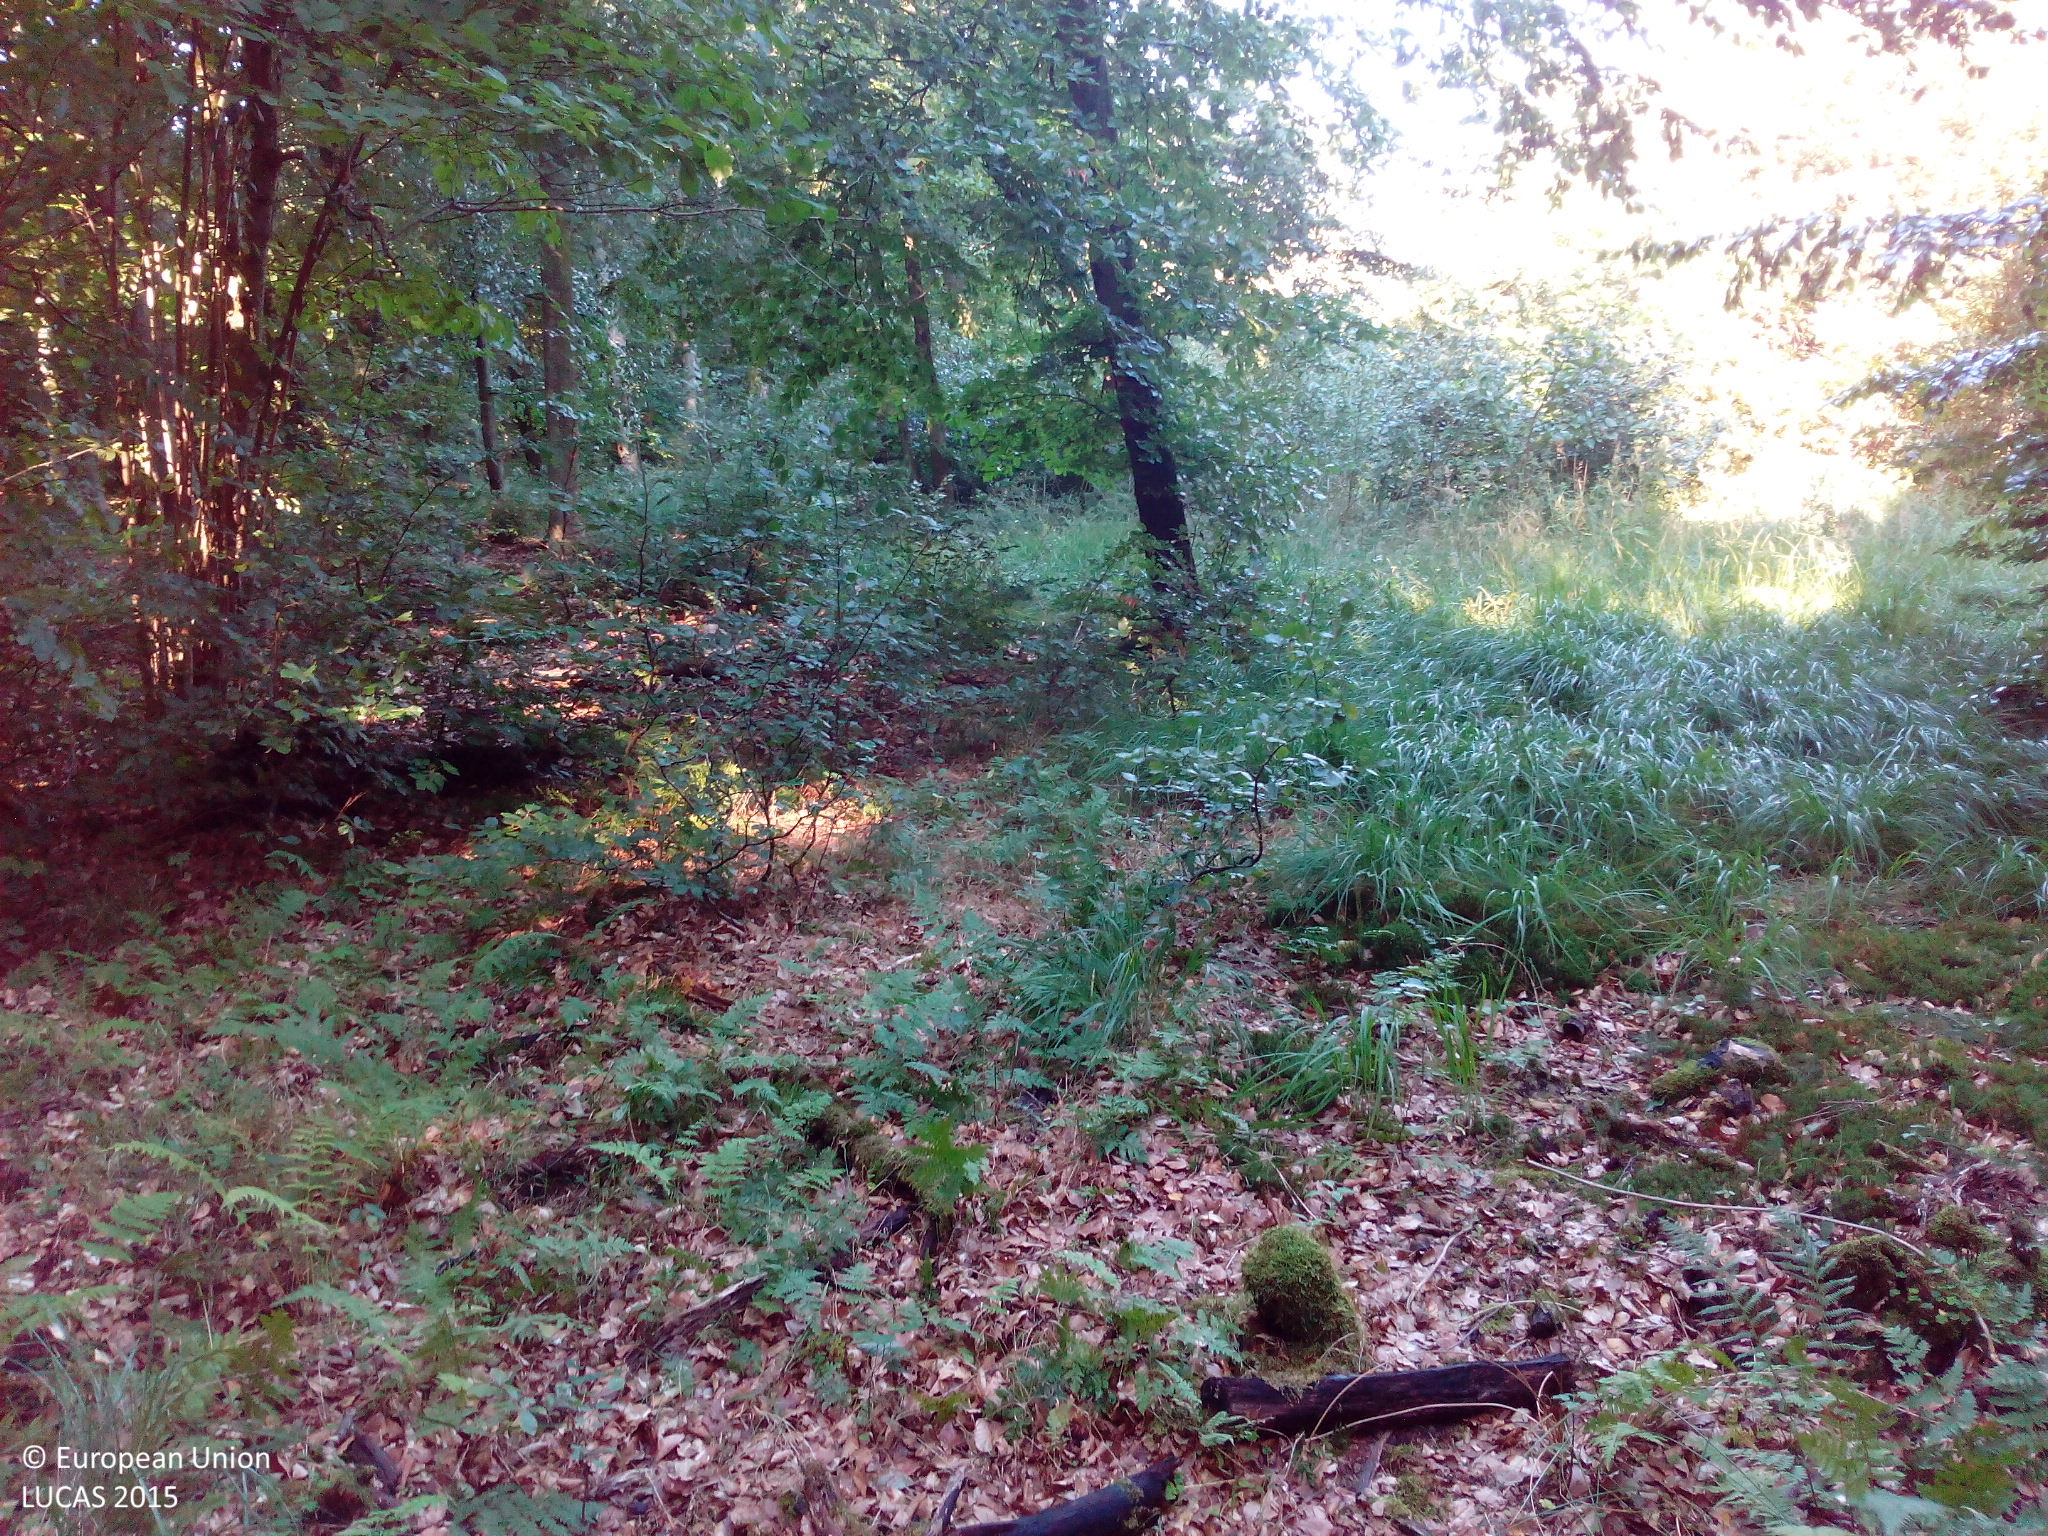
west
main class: Woodland
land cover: Broadleaved woodland
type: beech forest
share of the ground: > 75 %
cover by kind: broadleaved forest trees 85 %, herbaceous plants 10 %, shrubs 5 %
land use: Forestry
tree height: > 5 m
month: September
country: DE
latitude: 54.2064
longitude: 12.3447
